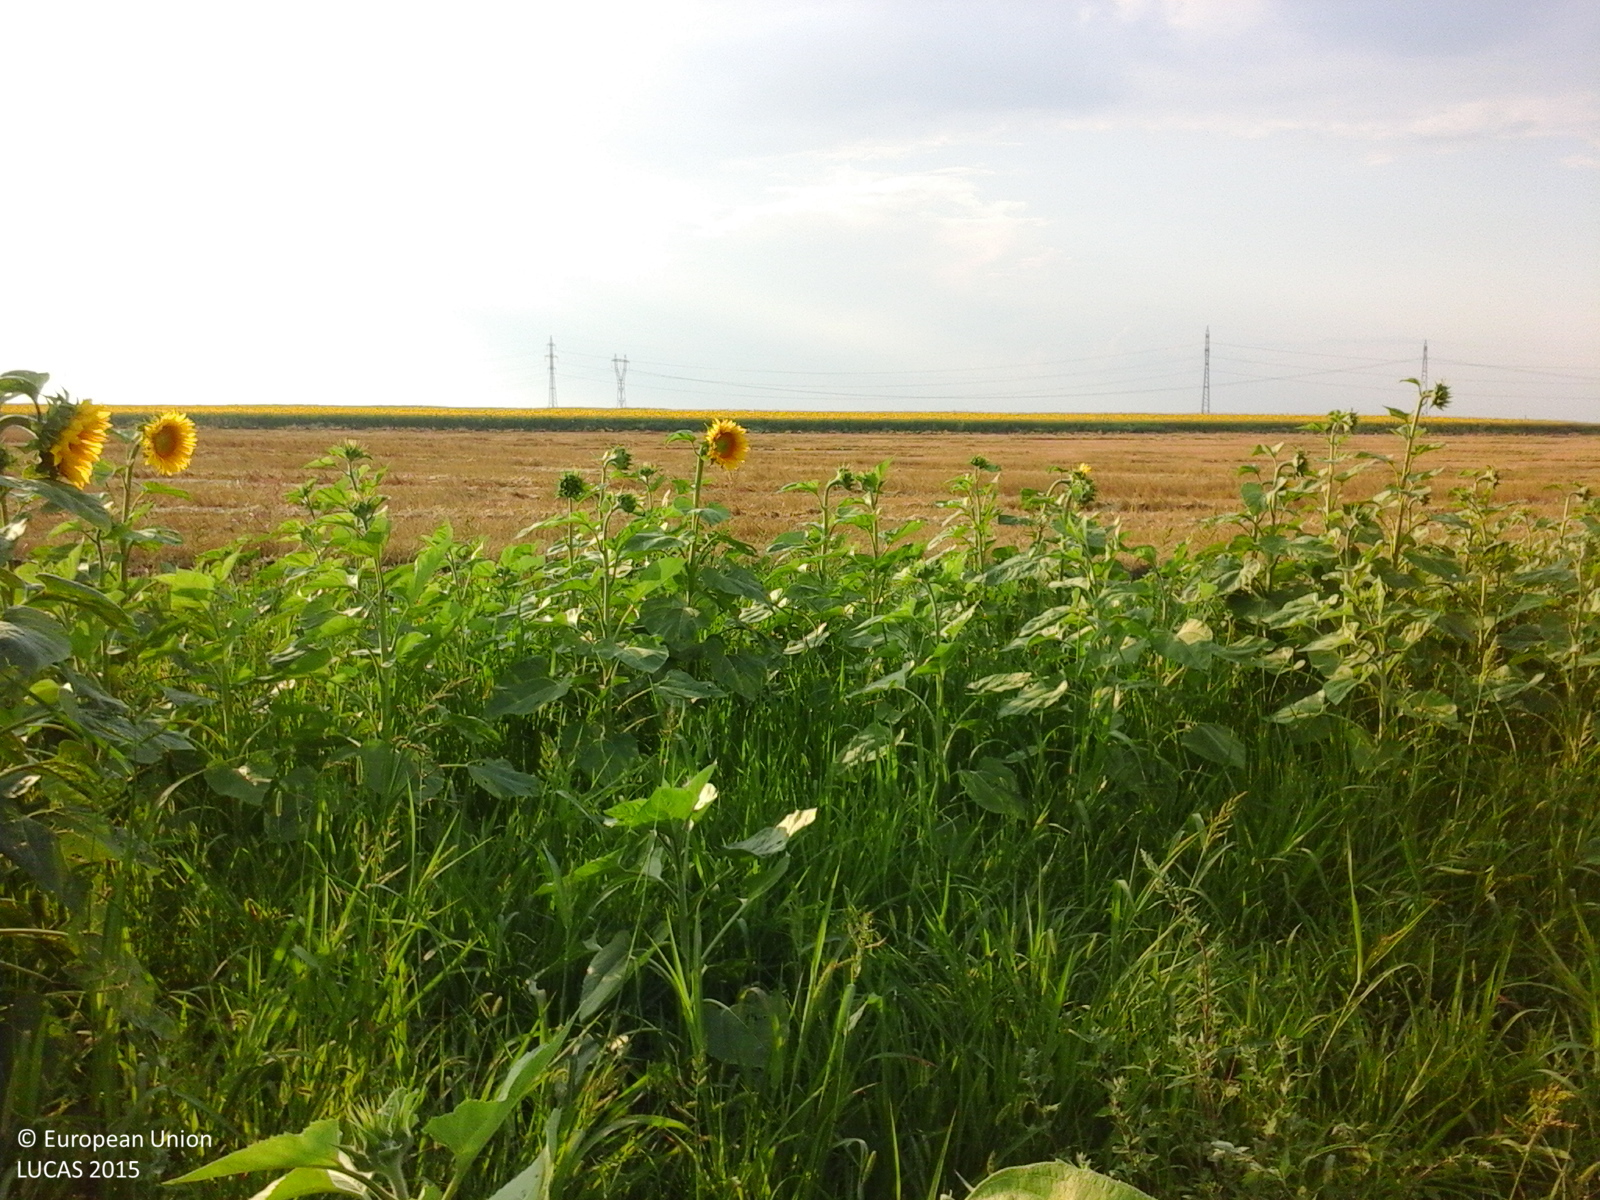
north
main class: Cropland
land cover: Sunflower
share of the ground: > 75 %
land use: Agriculture (excluding fallow land and kitchen gardens)
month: July
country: RO
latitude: 43.9237
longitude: 25.4162
